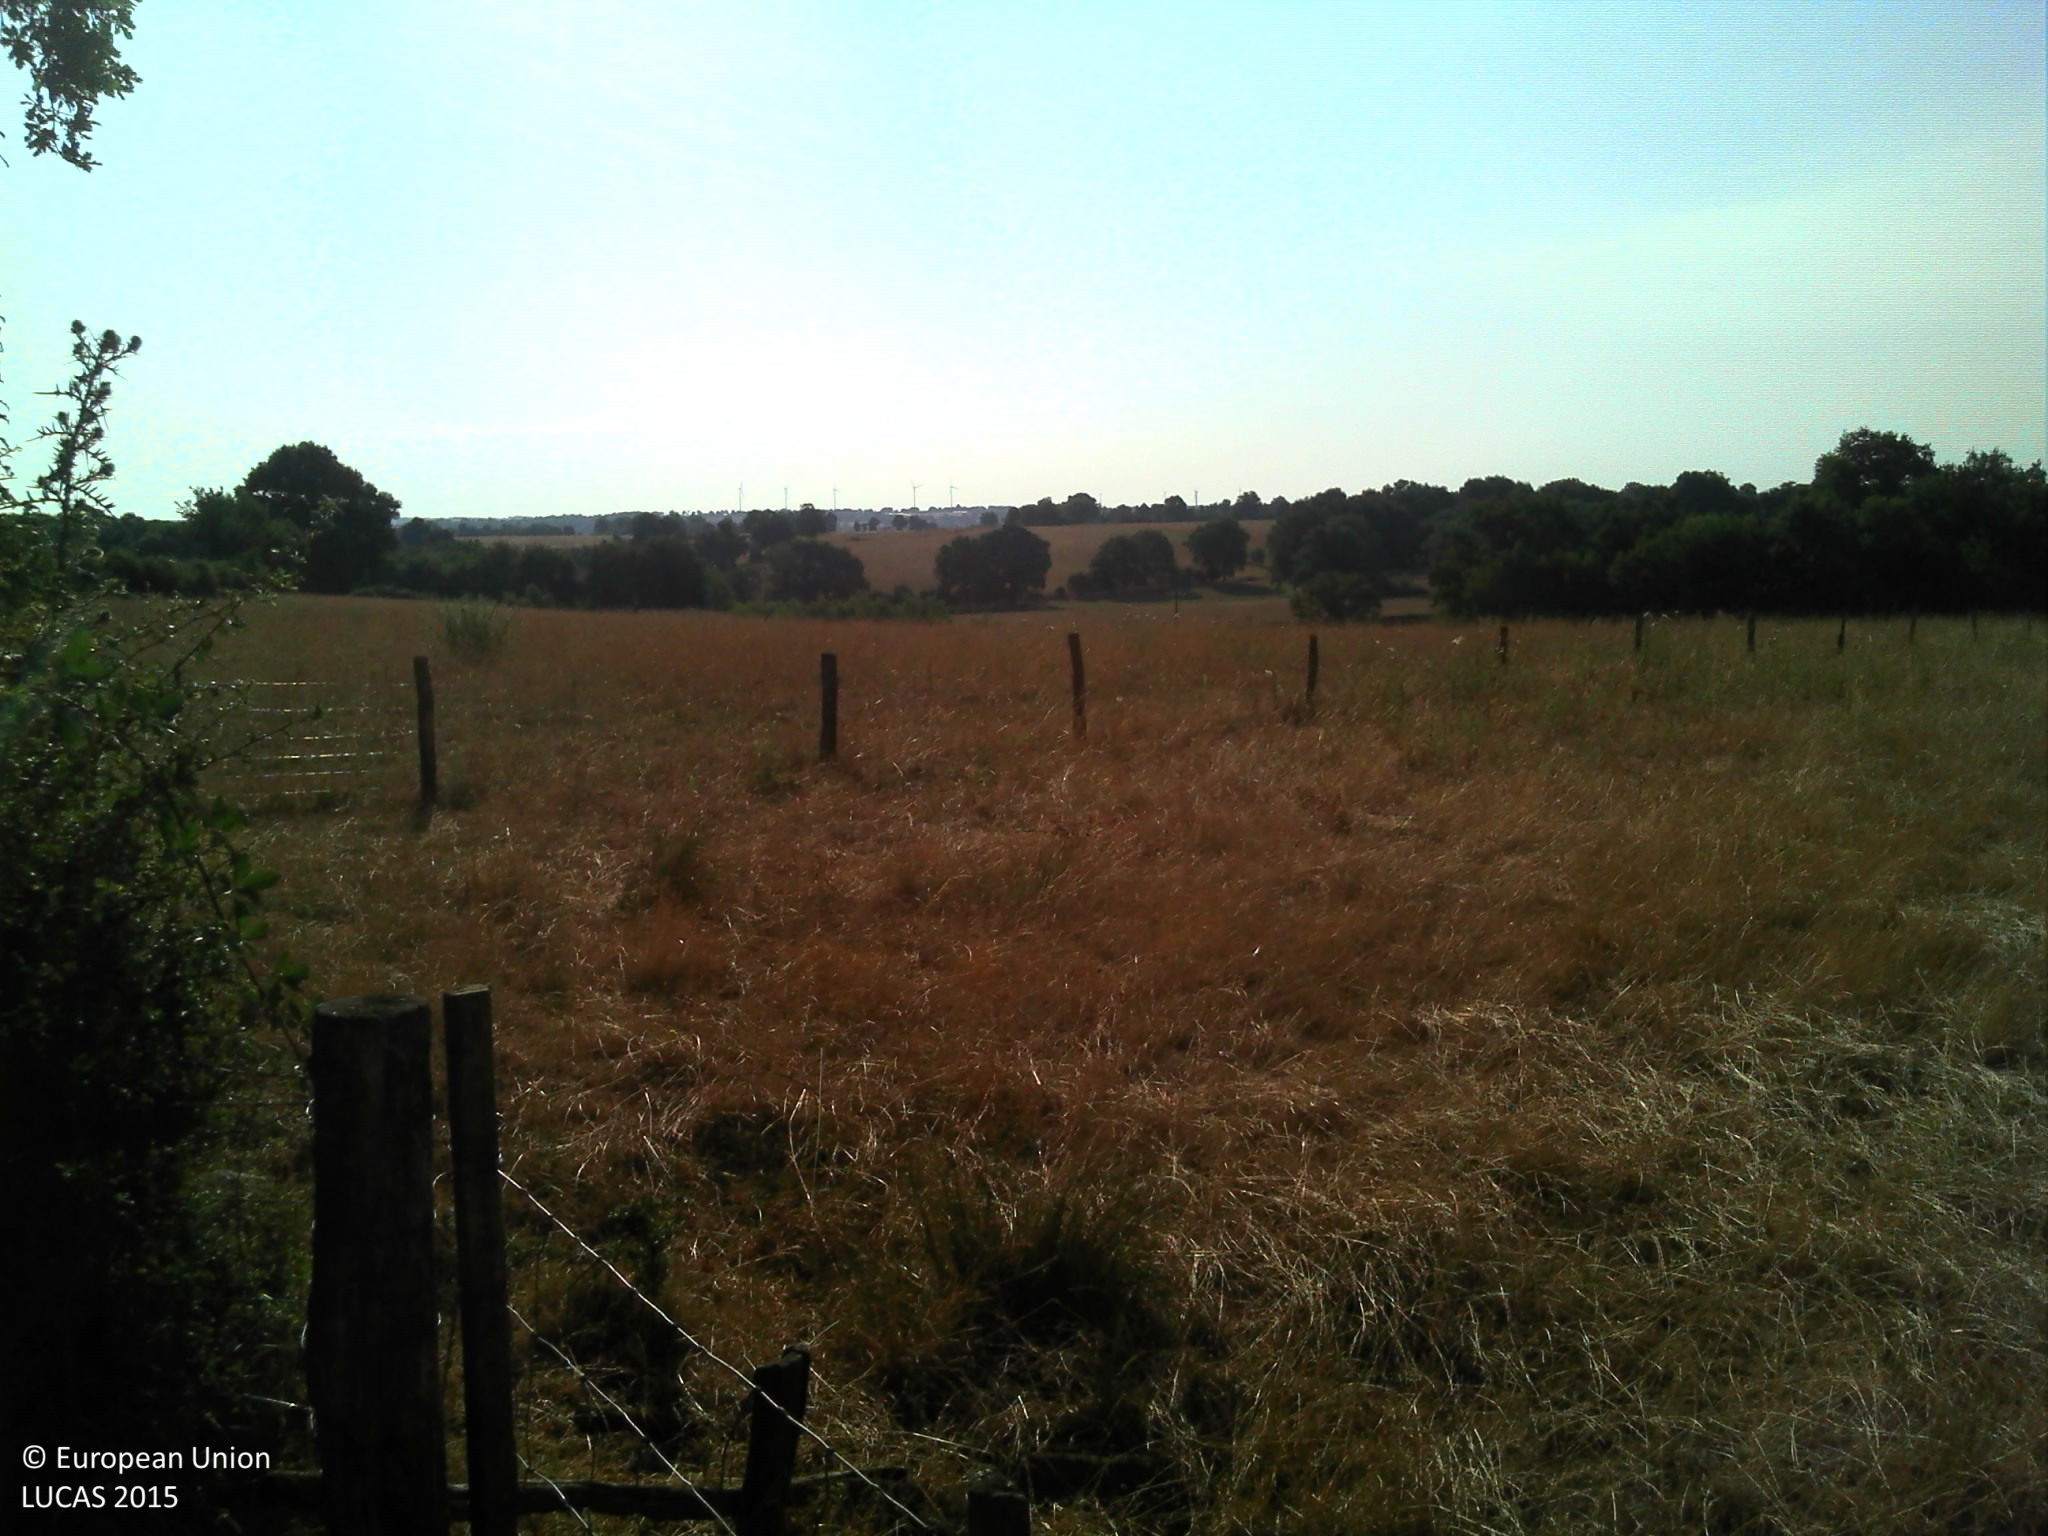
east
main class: Grassland
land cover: Grassland without tree/shrub cover
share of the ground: > 75 %
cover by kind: herbaceous plants 100 %
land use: Agriculture (excluding fallow land and kitchen gardens)
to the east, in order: Grassland without tree/shrub cover; Fences; Grassland without tree/shrub cover; Electric lines; Grassland without tree/shrub cover
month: July
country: FR
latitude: 46.2676
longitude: 0.6557
